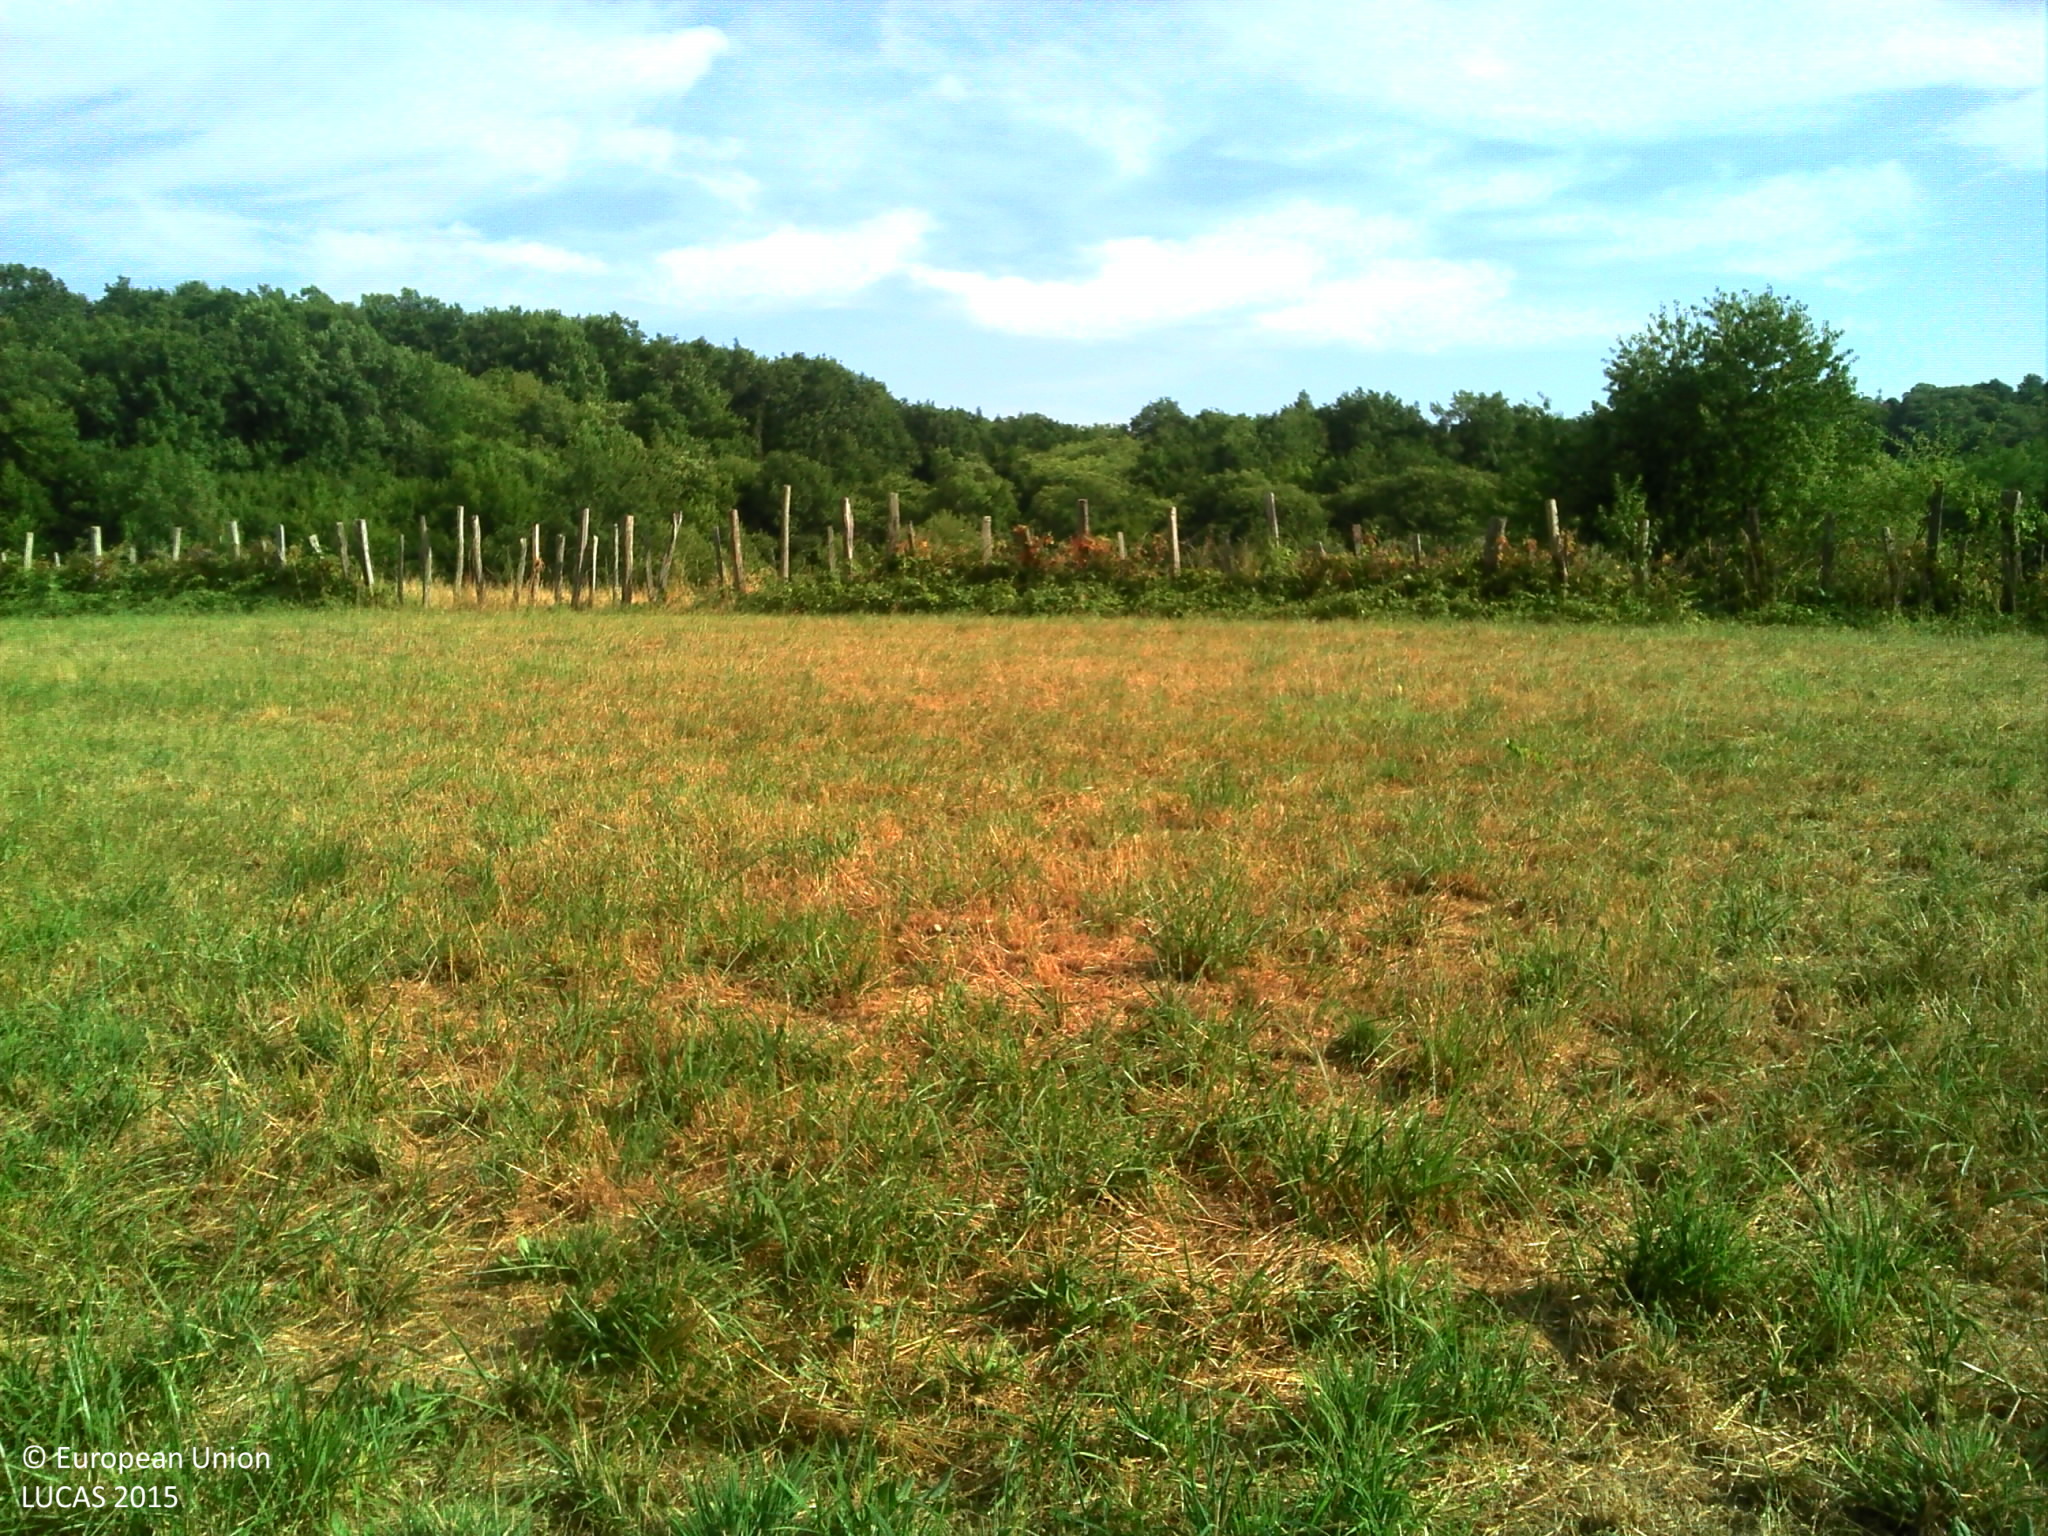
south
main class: Grassland
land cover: Grassland without tree/shrub cover
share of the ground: > 75 %
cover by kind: herbaceous plants 100 %
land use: Agriculture (excluding fallow land and kitchen gardens)
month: July
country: FR
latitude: 45.6028
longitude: 5.4016
